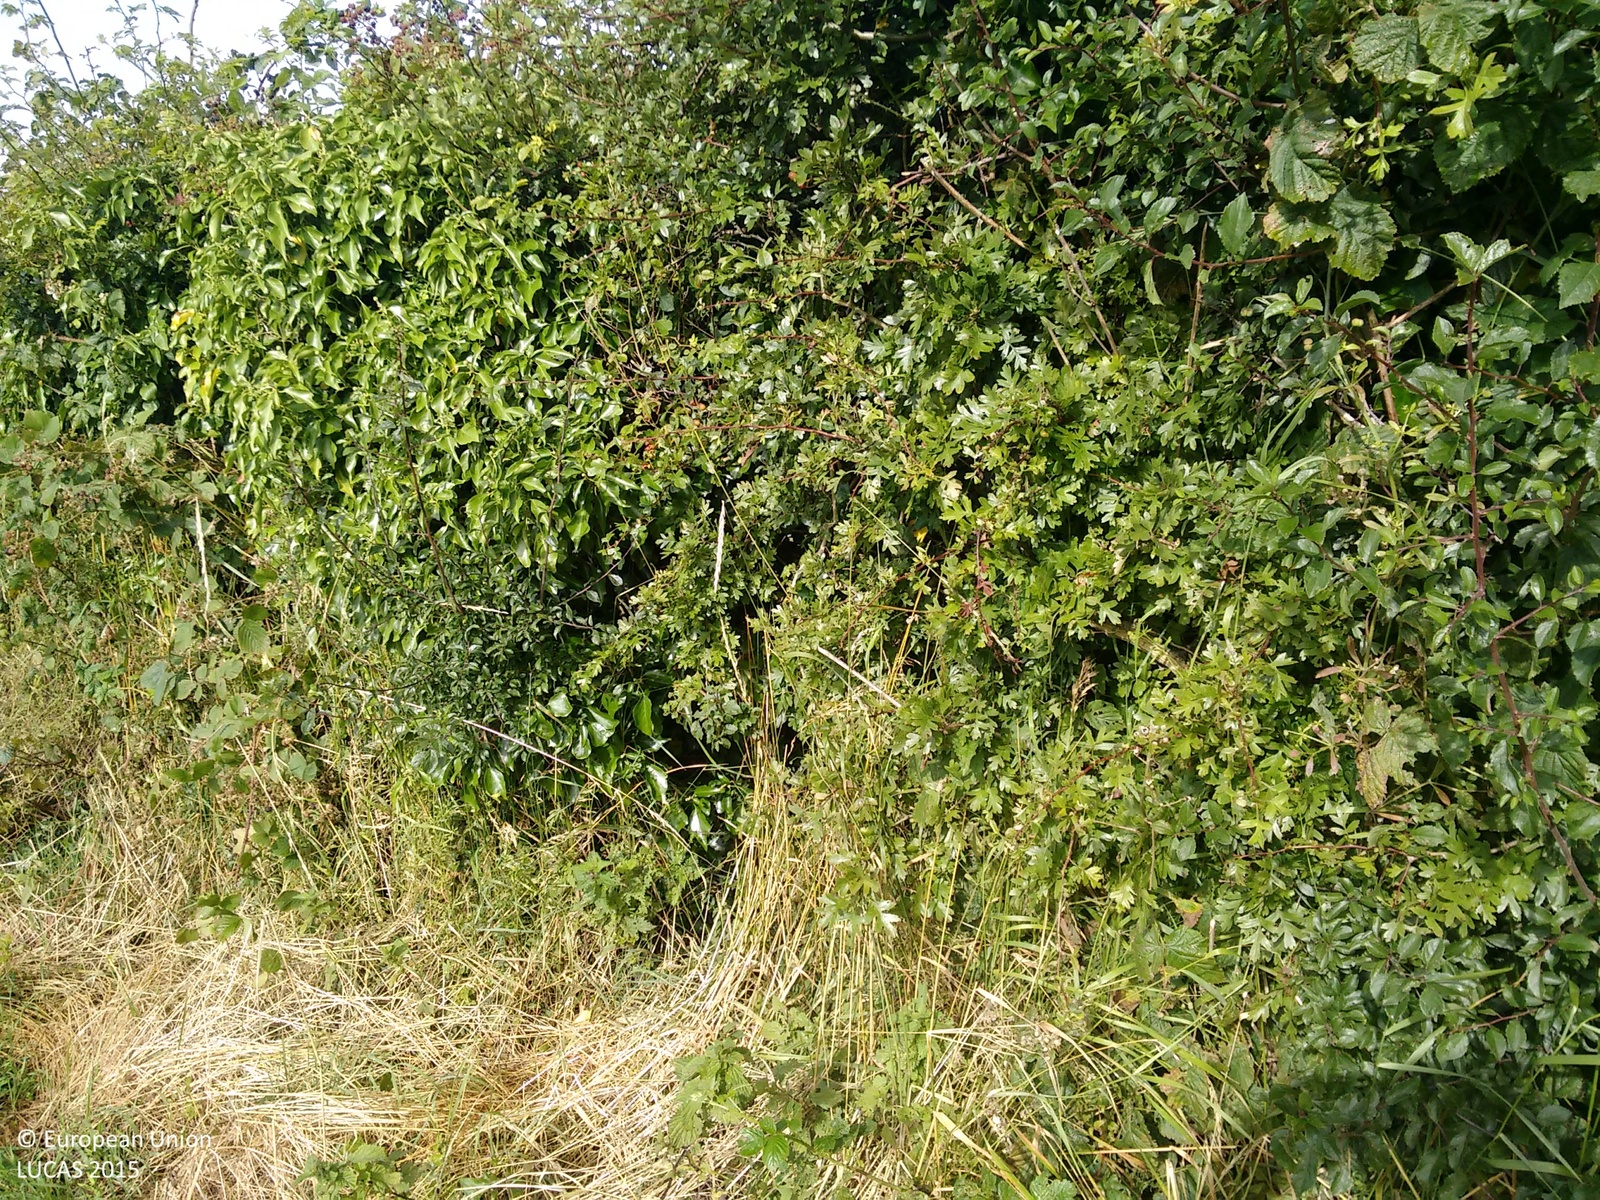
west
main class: Grassland
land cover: Grassland without tree/shrub cover
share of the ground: > 75 %
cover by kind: herbaceous plants 100 %
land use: Agriculture (excluding fallow land and kitchen gardens)
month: August
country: GB
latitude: 54.4715
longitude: -5.8926
